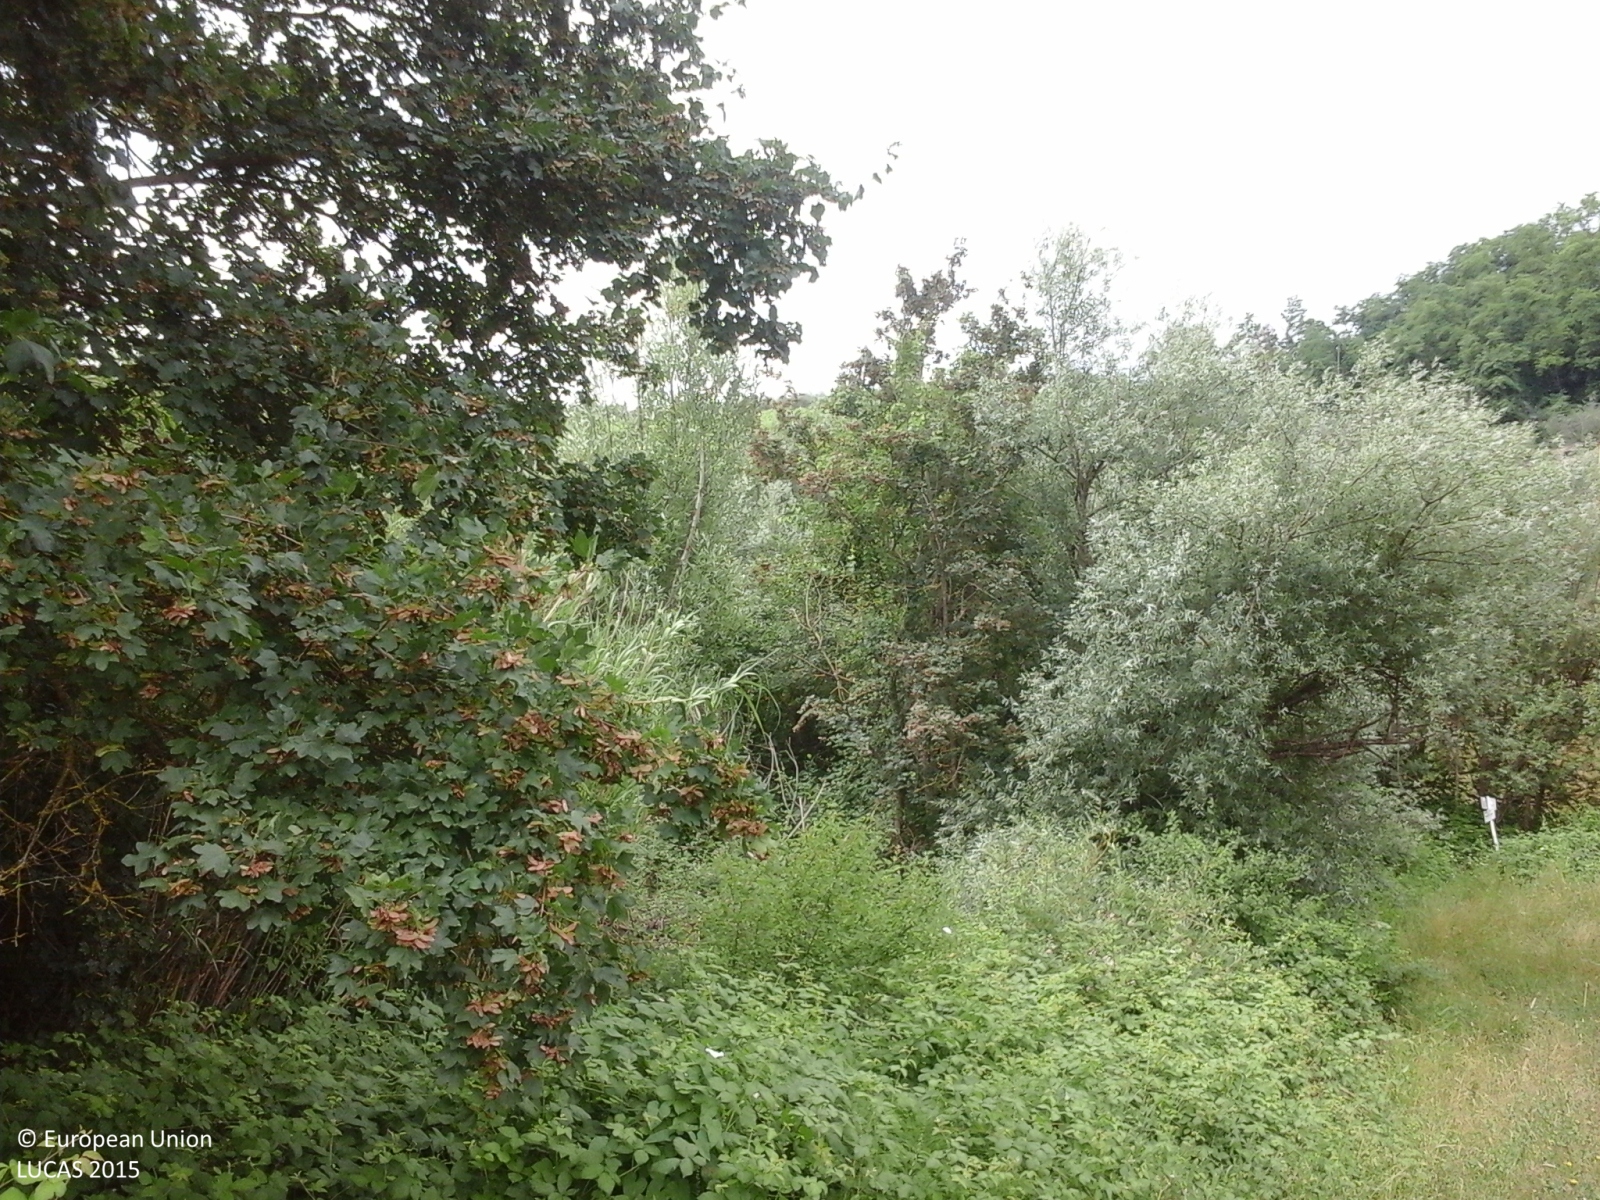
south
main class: Cropland
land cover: Temporary grasslands
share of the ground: > 75 %
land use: Agriculture (excluding fallow land and kitchen gardens)
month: August
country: IT
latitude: 43.6606
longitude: 10.9522
